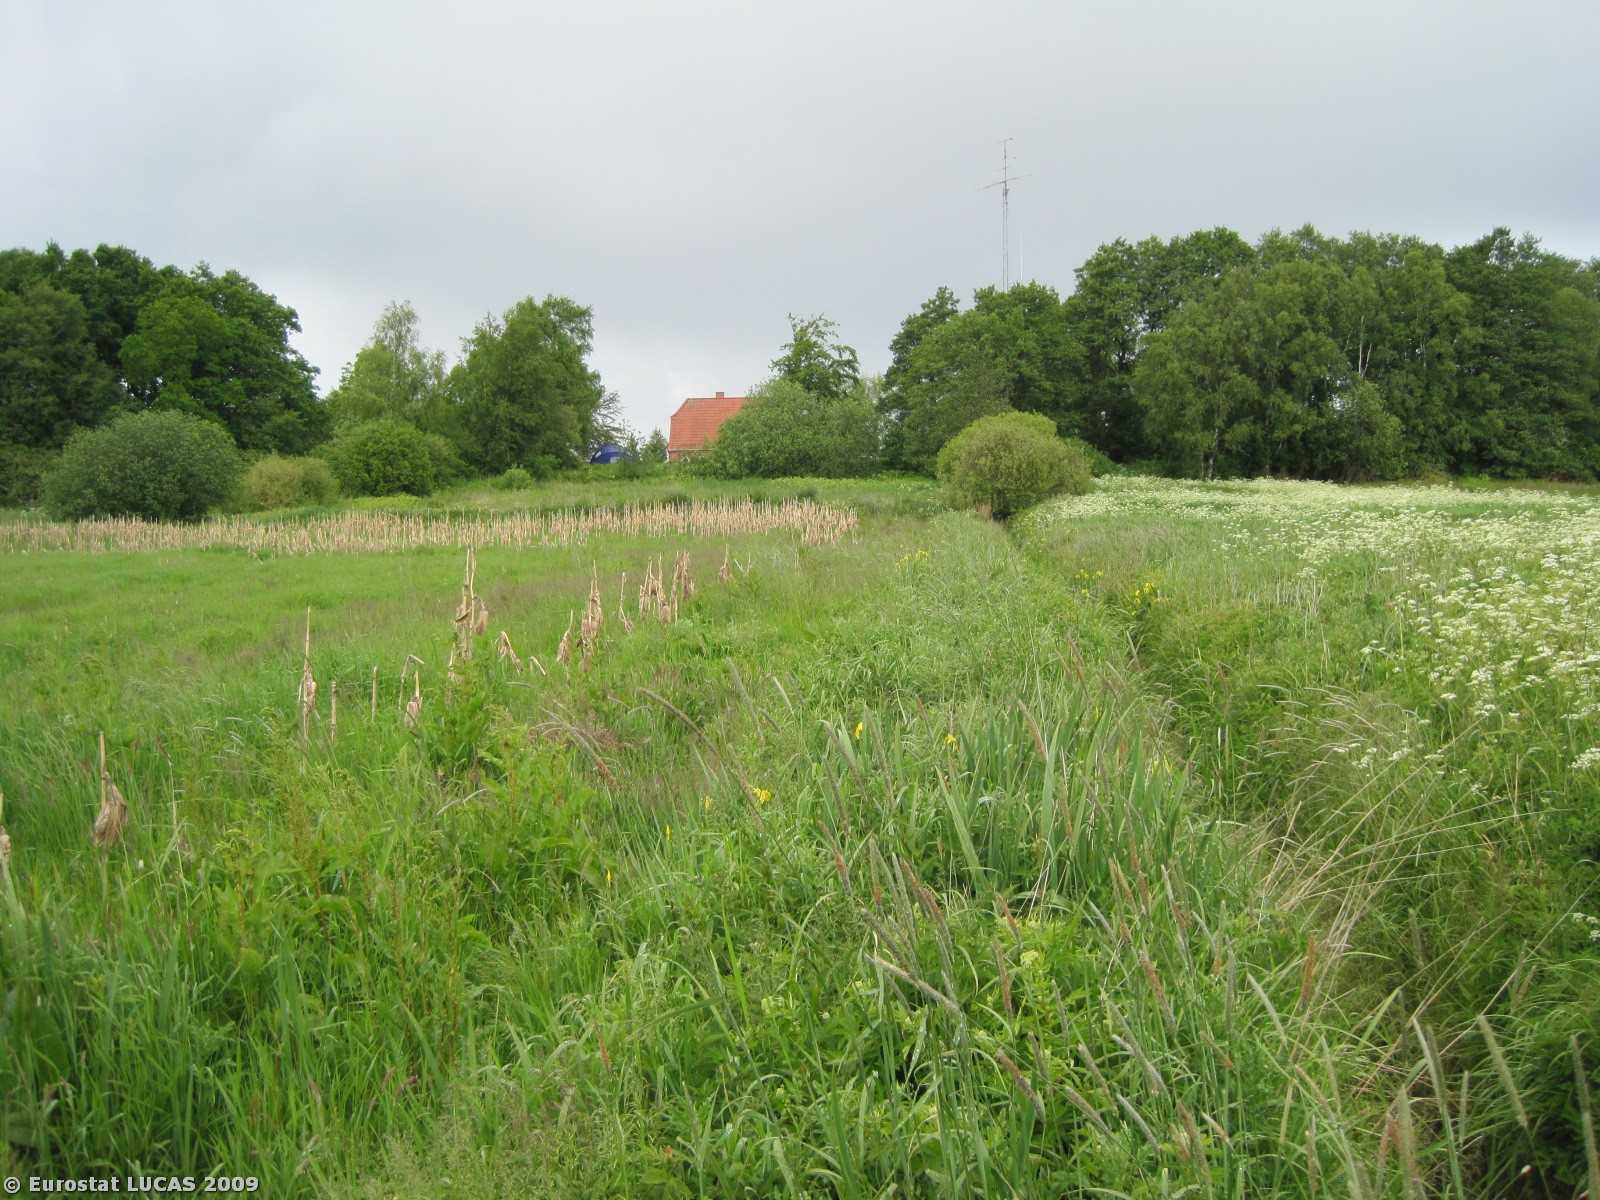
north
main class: Grassland
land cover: Grassland without tree/shrub cover
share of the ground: > 75 %
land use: Agriculture (excluding fallow land and kitchen gardens)
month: June
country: DK
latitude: 57.0503
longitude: 10.2798
